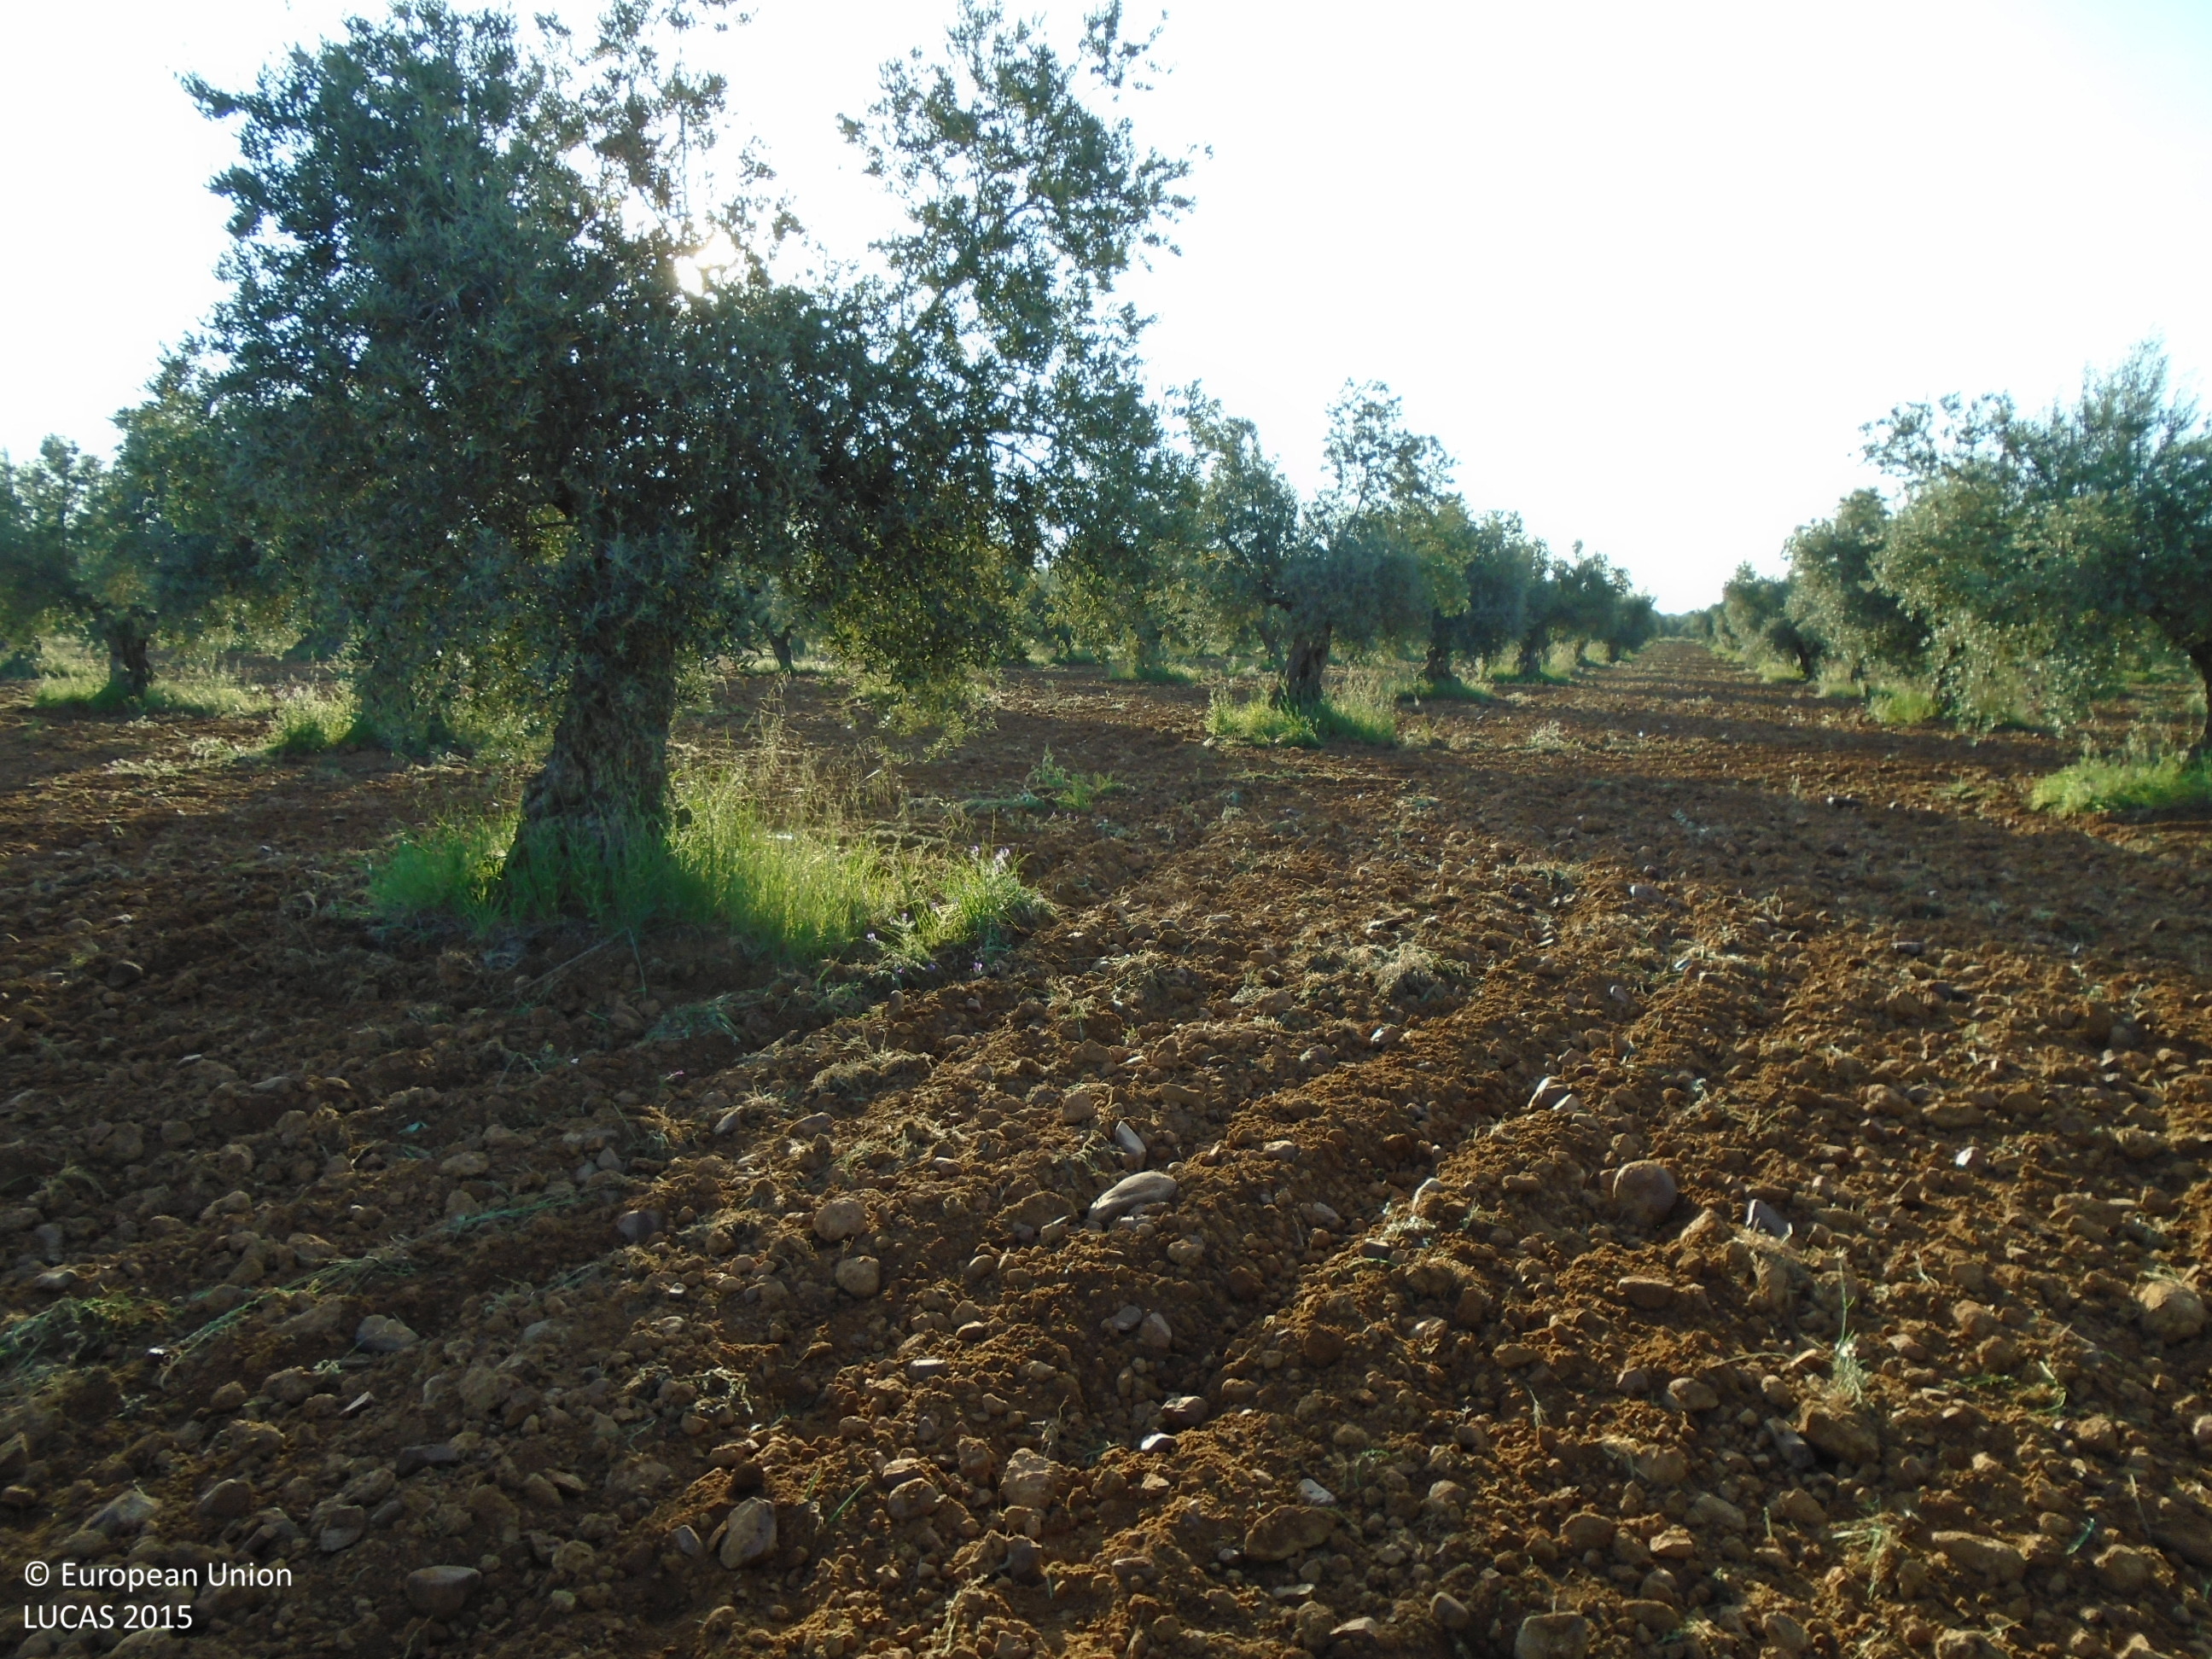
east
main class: Cropland
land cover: Olive groves
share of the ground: 10 - 25 %
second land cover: Other bare soil
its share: > 75 %
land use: Agriculture (excluding fallow land and kitchen gardens)
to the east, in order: Olive groves; Other bare soil
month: May
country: ES
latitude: 39.8100
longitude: -4.7269
